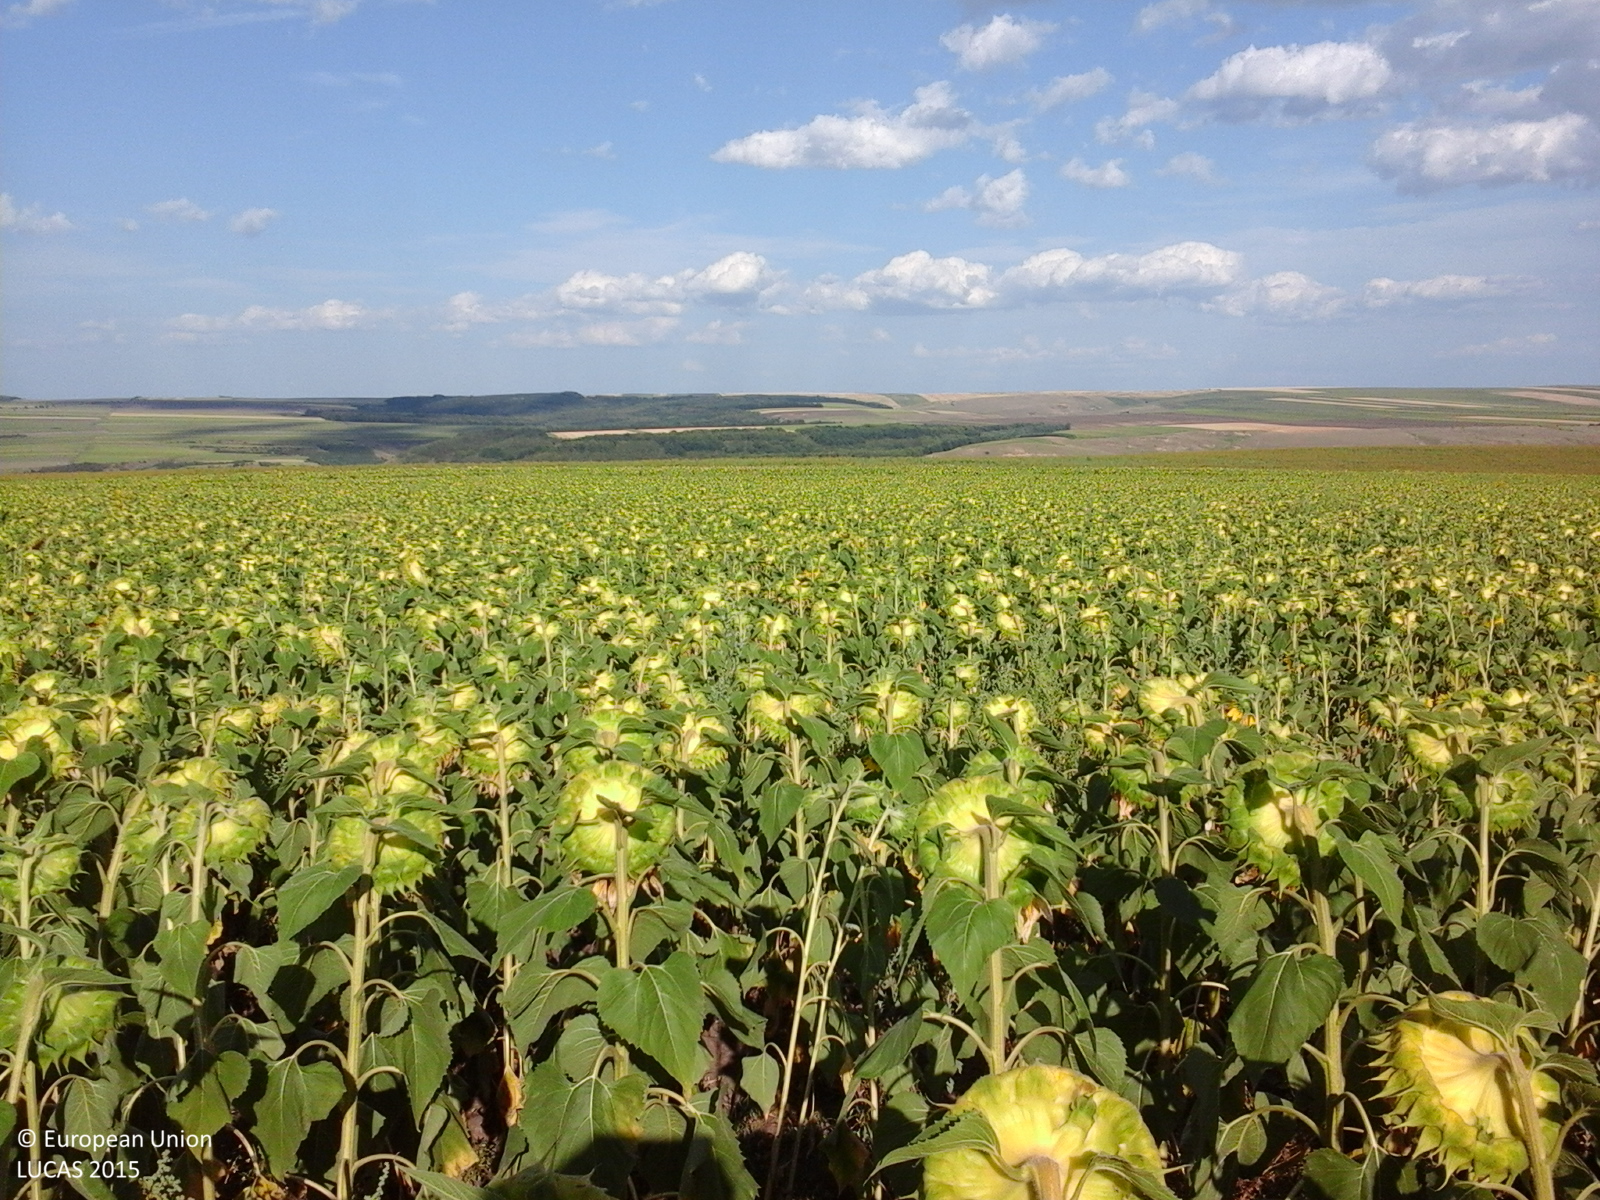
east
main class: Cropland
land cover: Sunflower
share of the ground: > 75 %
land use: Agriculture (excluding fallow land and kitchen gardens)
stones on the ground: < 10 %
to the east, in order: Sunflower; Maize
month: July
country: RO
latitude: 46.2341
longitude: 27.5243
